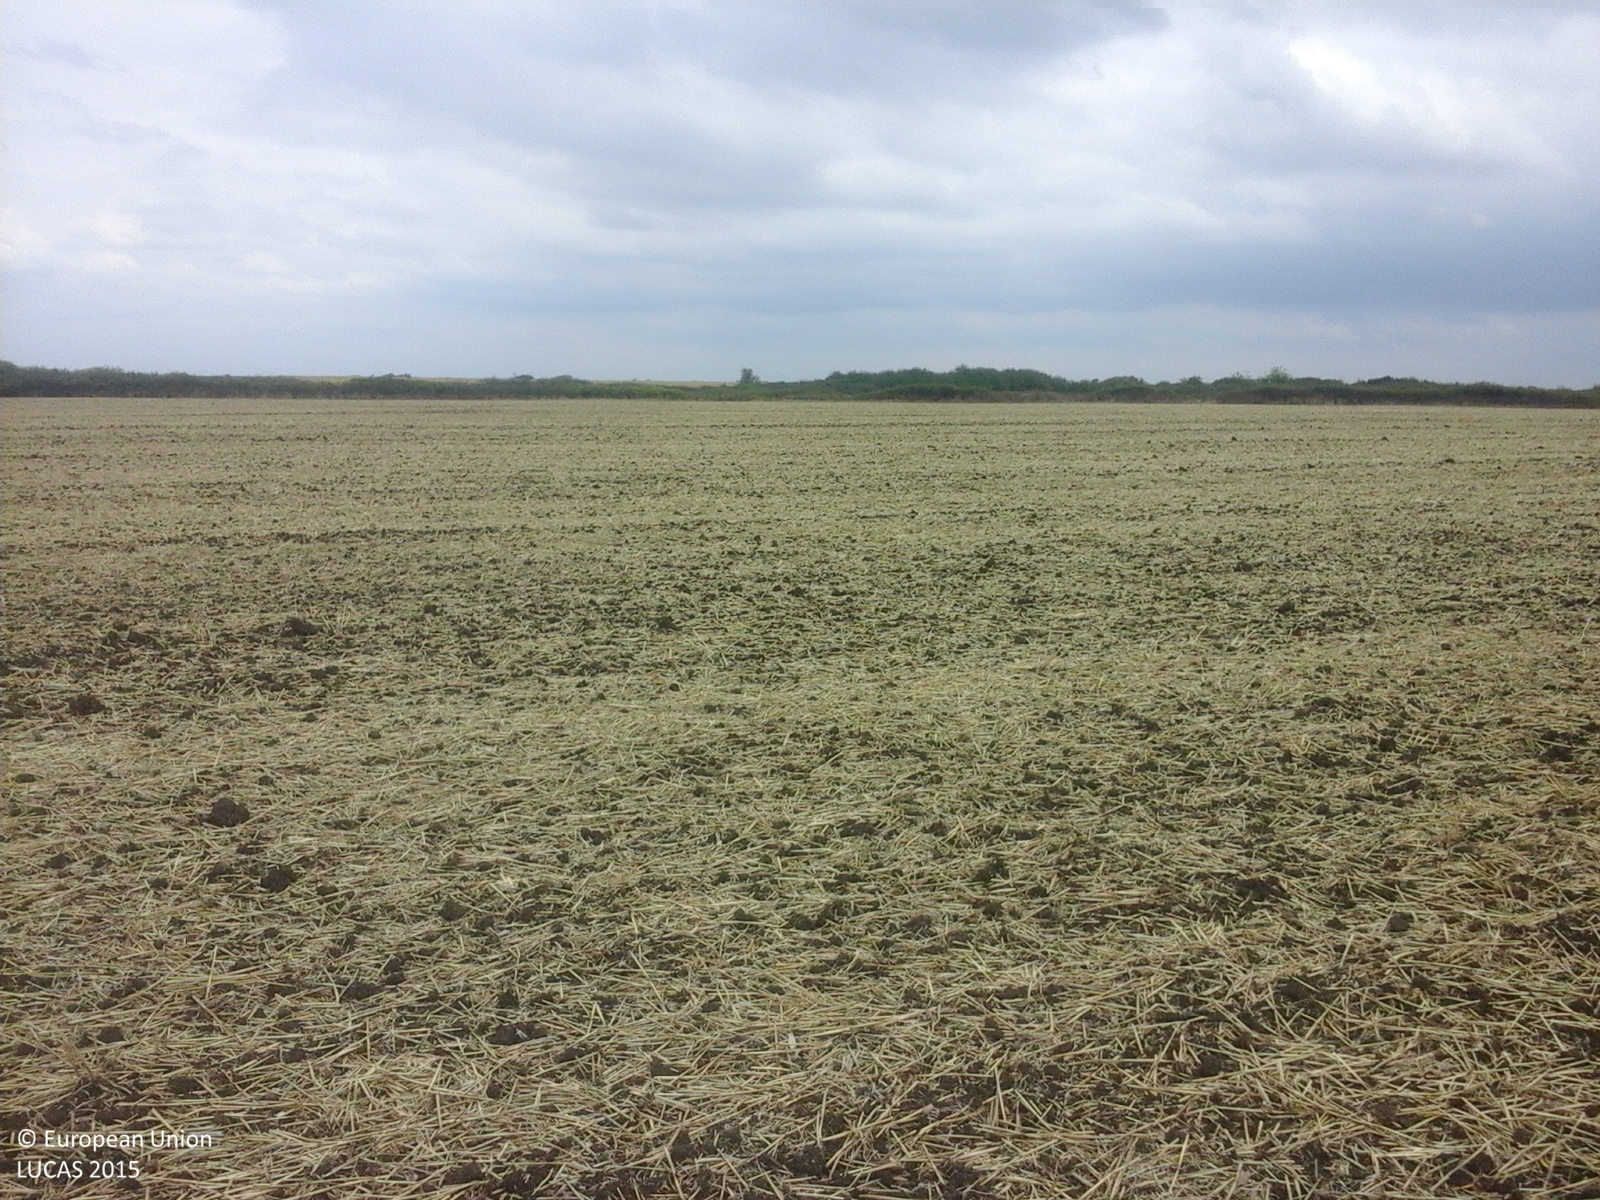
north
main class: Cropland
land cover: Common wheat
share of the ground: 10 - 25 %
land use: Agriculture (excluding fallow land and kitchen gardens)
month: August
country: RO
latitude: 45.5008
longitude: 21.2531
